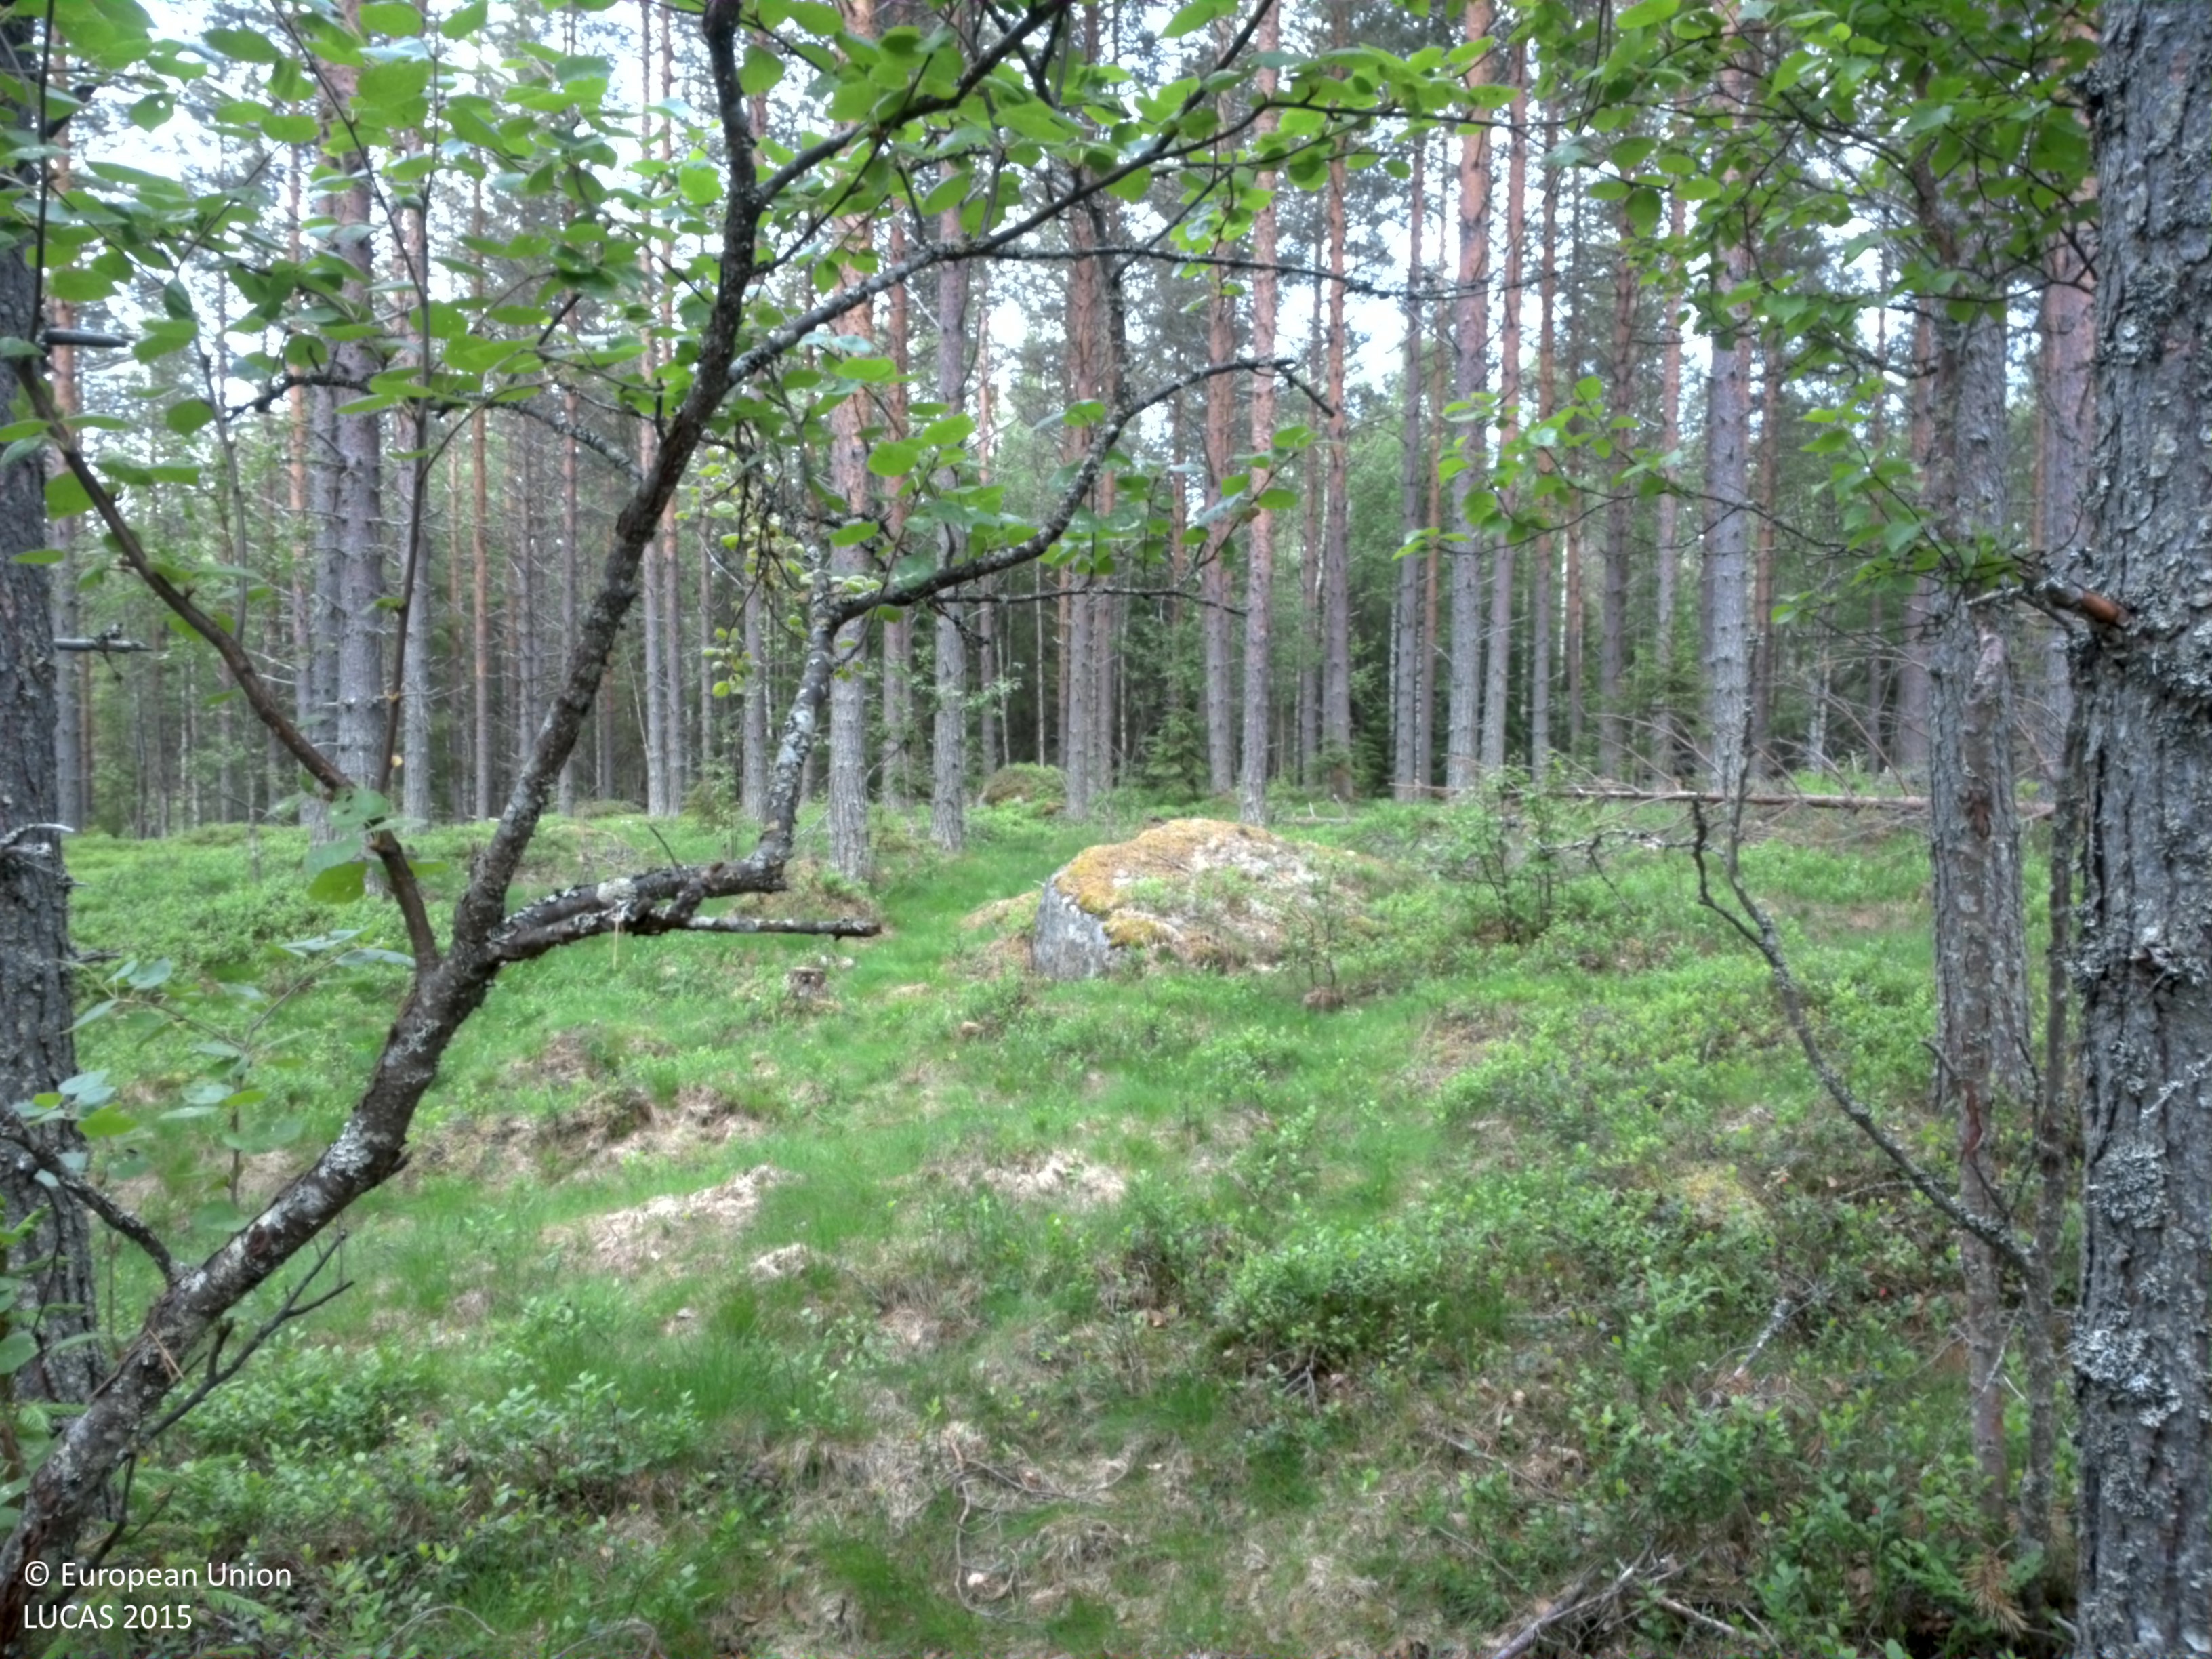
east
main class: Woodland
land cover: Pine dominated mixed woodland
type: boreal forest
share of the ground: 50 - 75 %
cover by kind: coniferous forest trees 45 %, shrubs 30 %, broadleaved forest trees 15 %, herbaceous plants 10 %
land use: Forestry
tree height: > 5 m
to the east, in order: Pine dominated mixed woodland; Pine dominated coniferous woodland; Ditches and canals; Spruce dominated mixed woodland; Pine dominated coniferous woodland; Pine dominated mixed woodland; Shrubland with sparse tree cover; Broadleaved woodland; Paved roads, cycling and walking lanes; Ditches and canals; Pine dominated mixed woodland
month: August
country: SE
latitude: 64.5291
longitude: 18.2414
